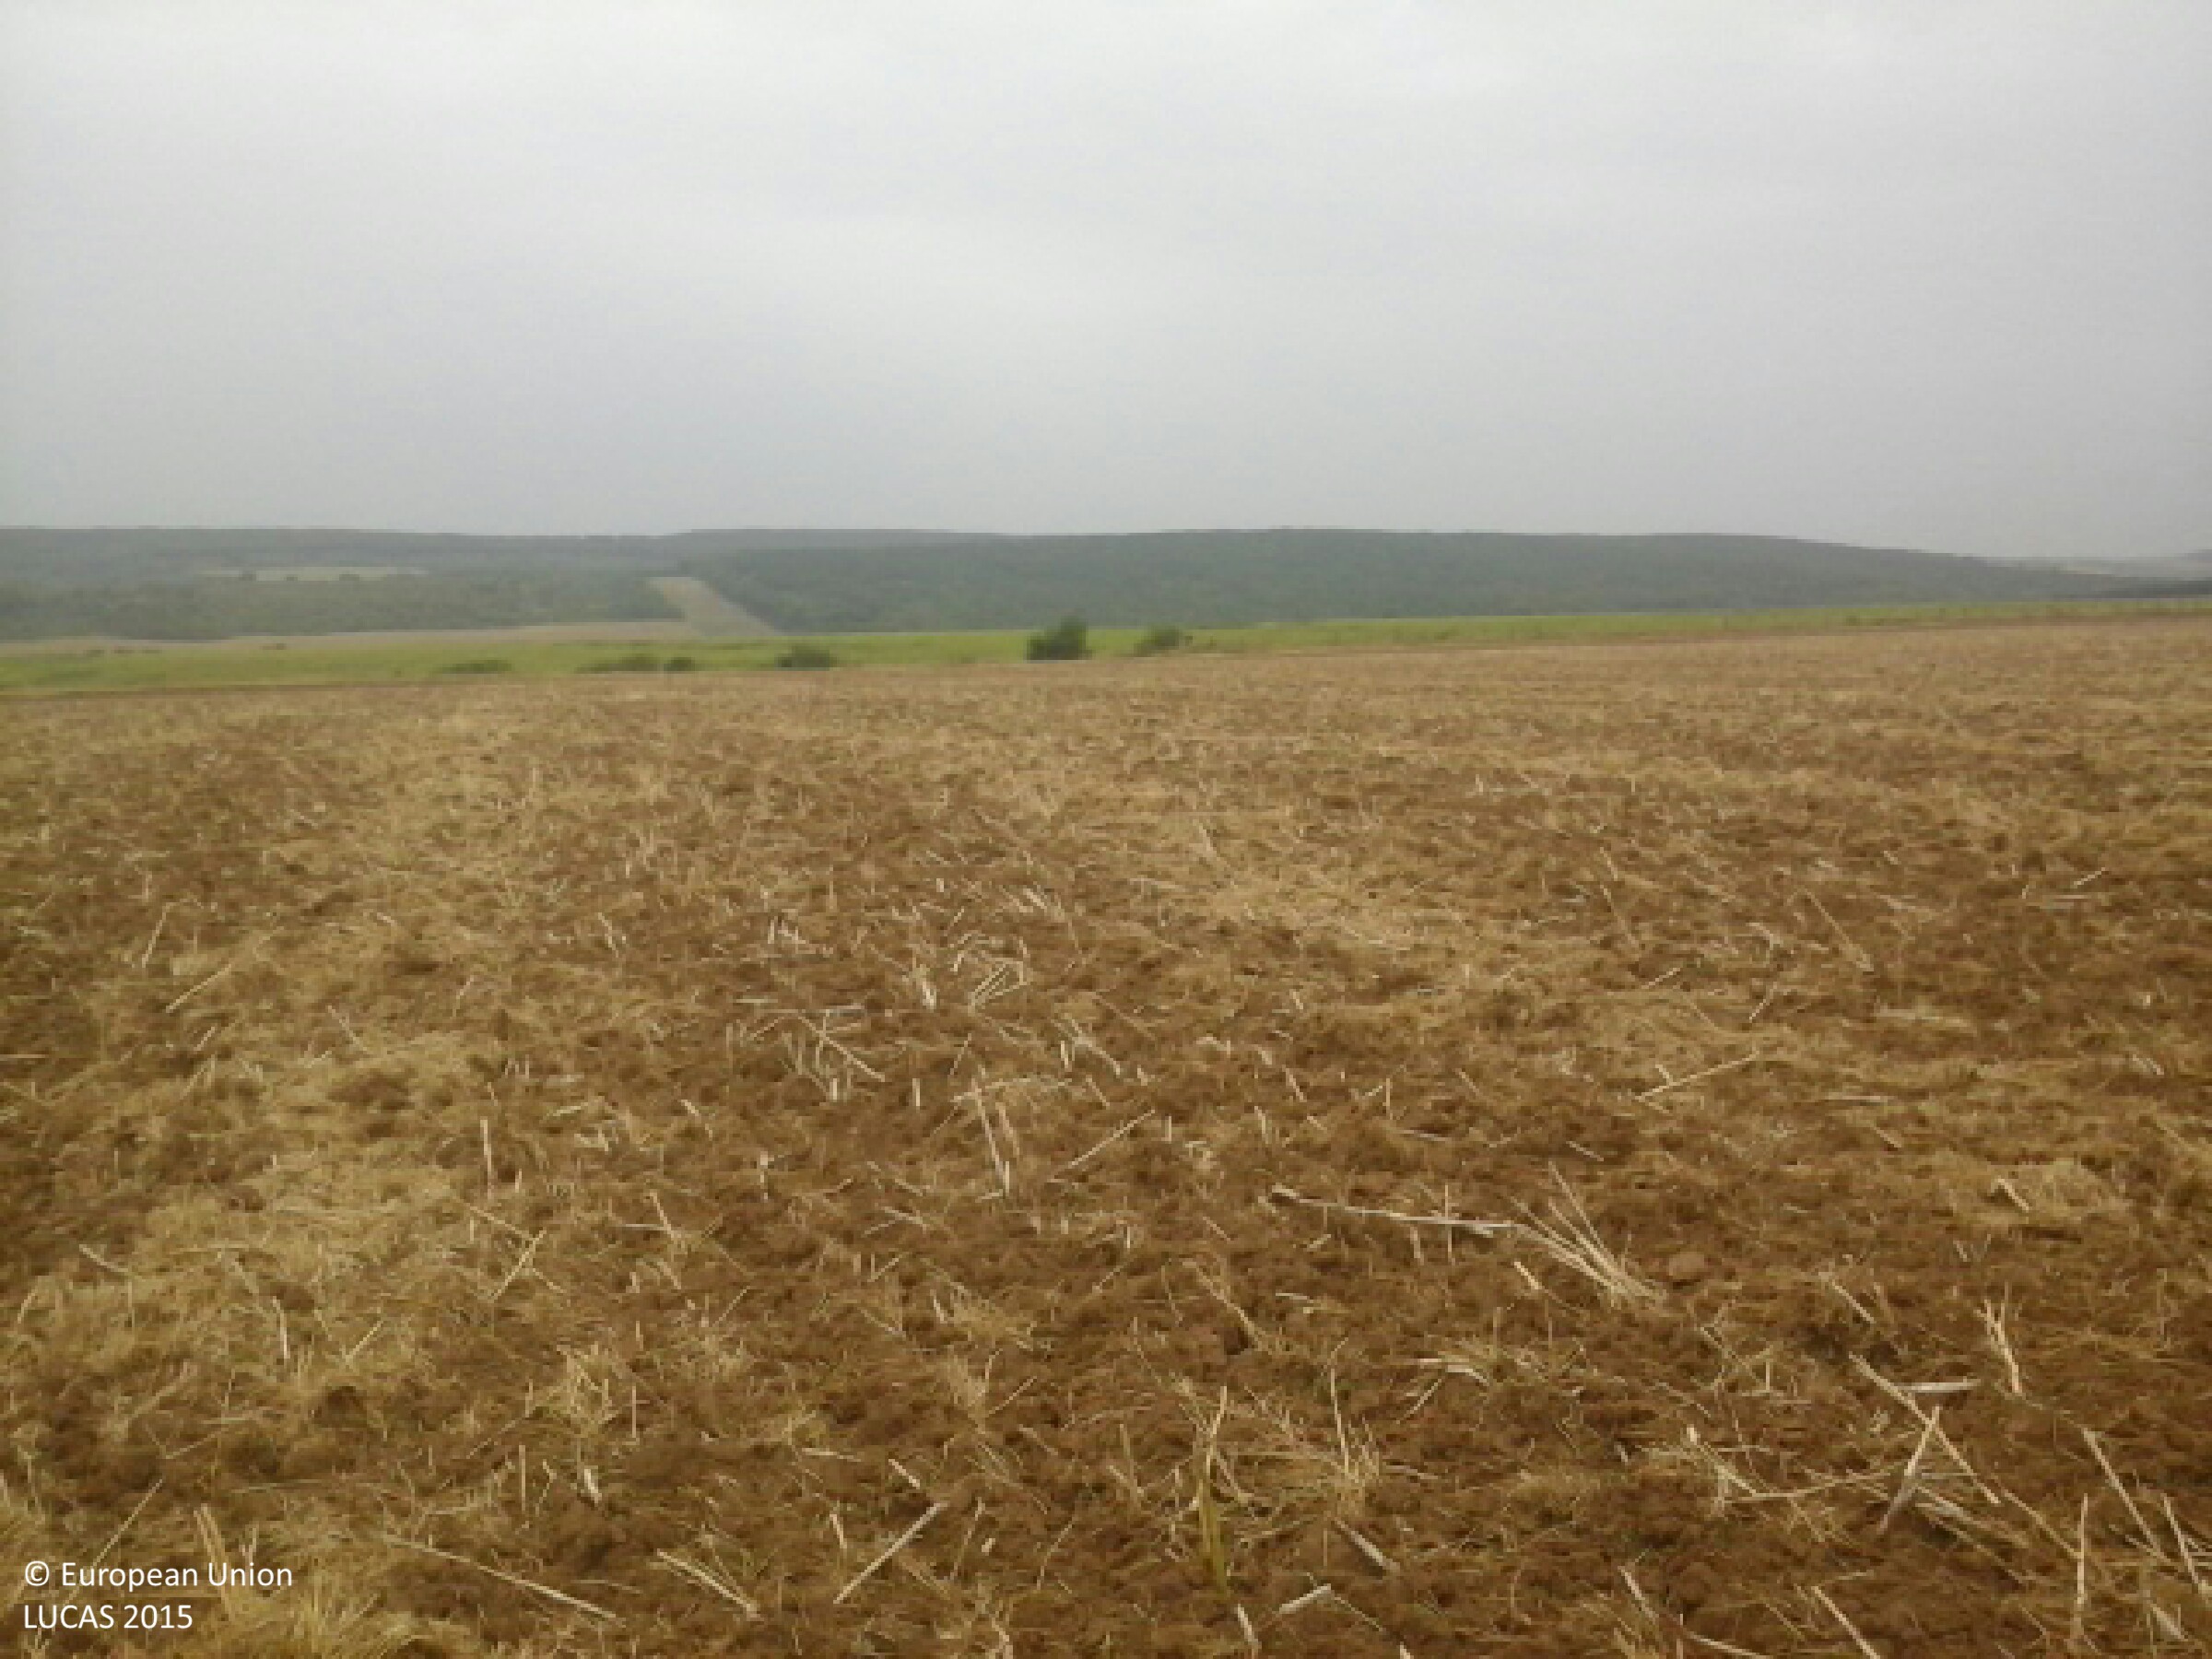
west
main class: Cropland
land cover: Rape and turnip rape
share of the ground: < 10 %
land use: Agriculture (excluding fallow land and kitchen gardens)
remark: Harvested field
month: July
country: HU
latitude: 48.4025
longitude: 21.1319
